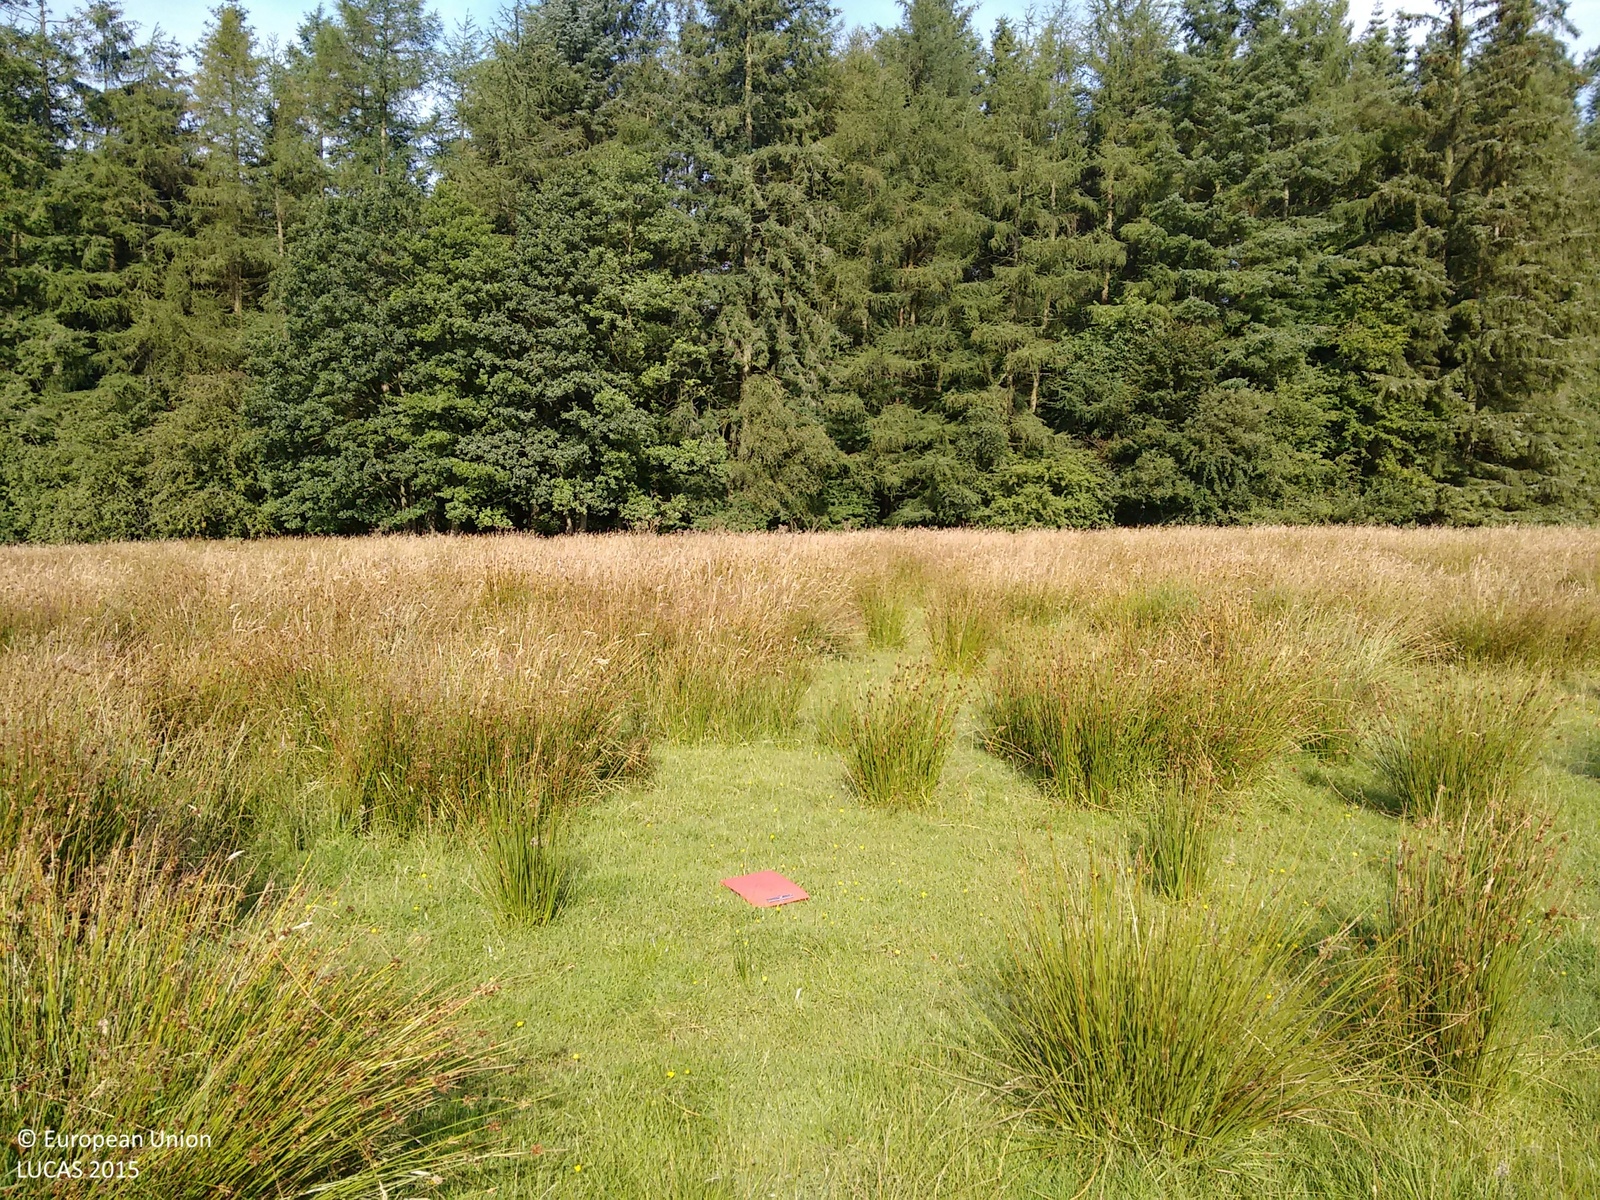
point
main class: Grassland
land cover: Grassland without tree/shrub cover
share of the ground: > 75 %
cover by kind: herbaceous plants 100 %
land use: Agriculture (excluding fallow land and kitchen gardens)
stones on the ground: < 10 %
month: August
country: GB
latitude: 55.1064
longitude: -2.9705
